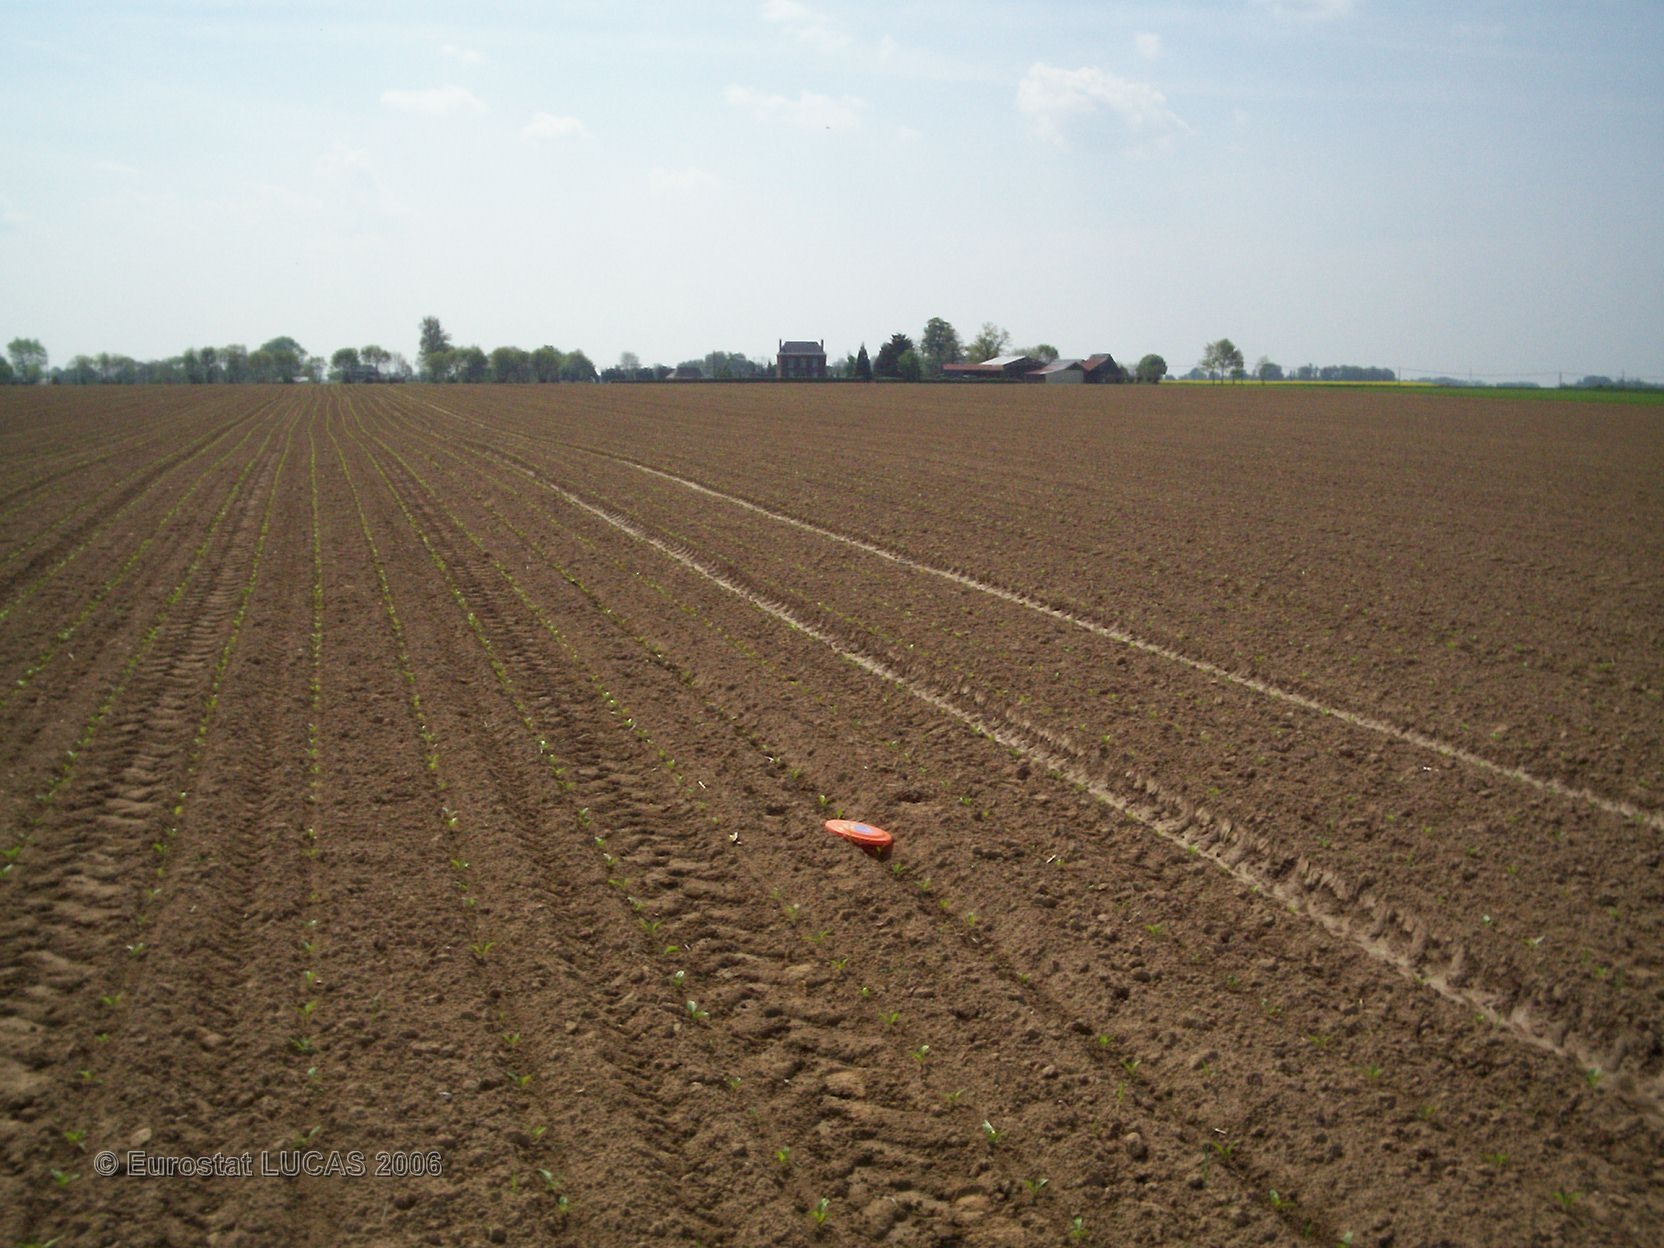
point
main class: Cropland
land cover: Sugar beet
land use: Agriculture (excluding fallow land and kitchen gardens)
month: May
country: FR
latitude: 49.1931
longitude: 0.5471
